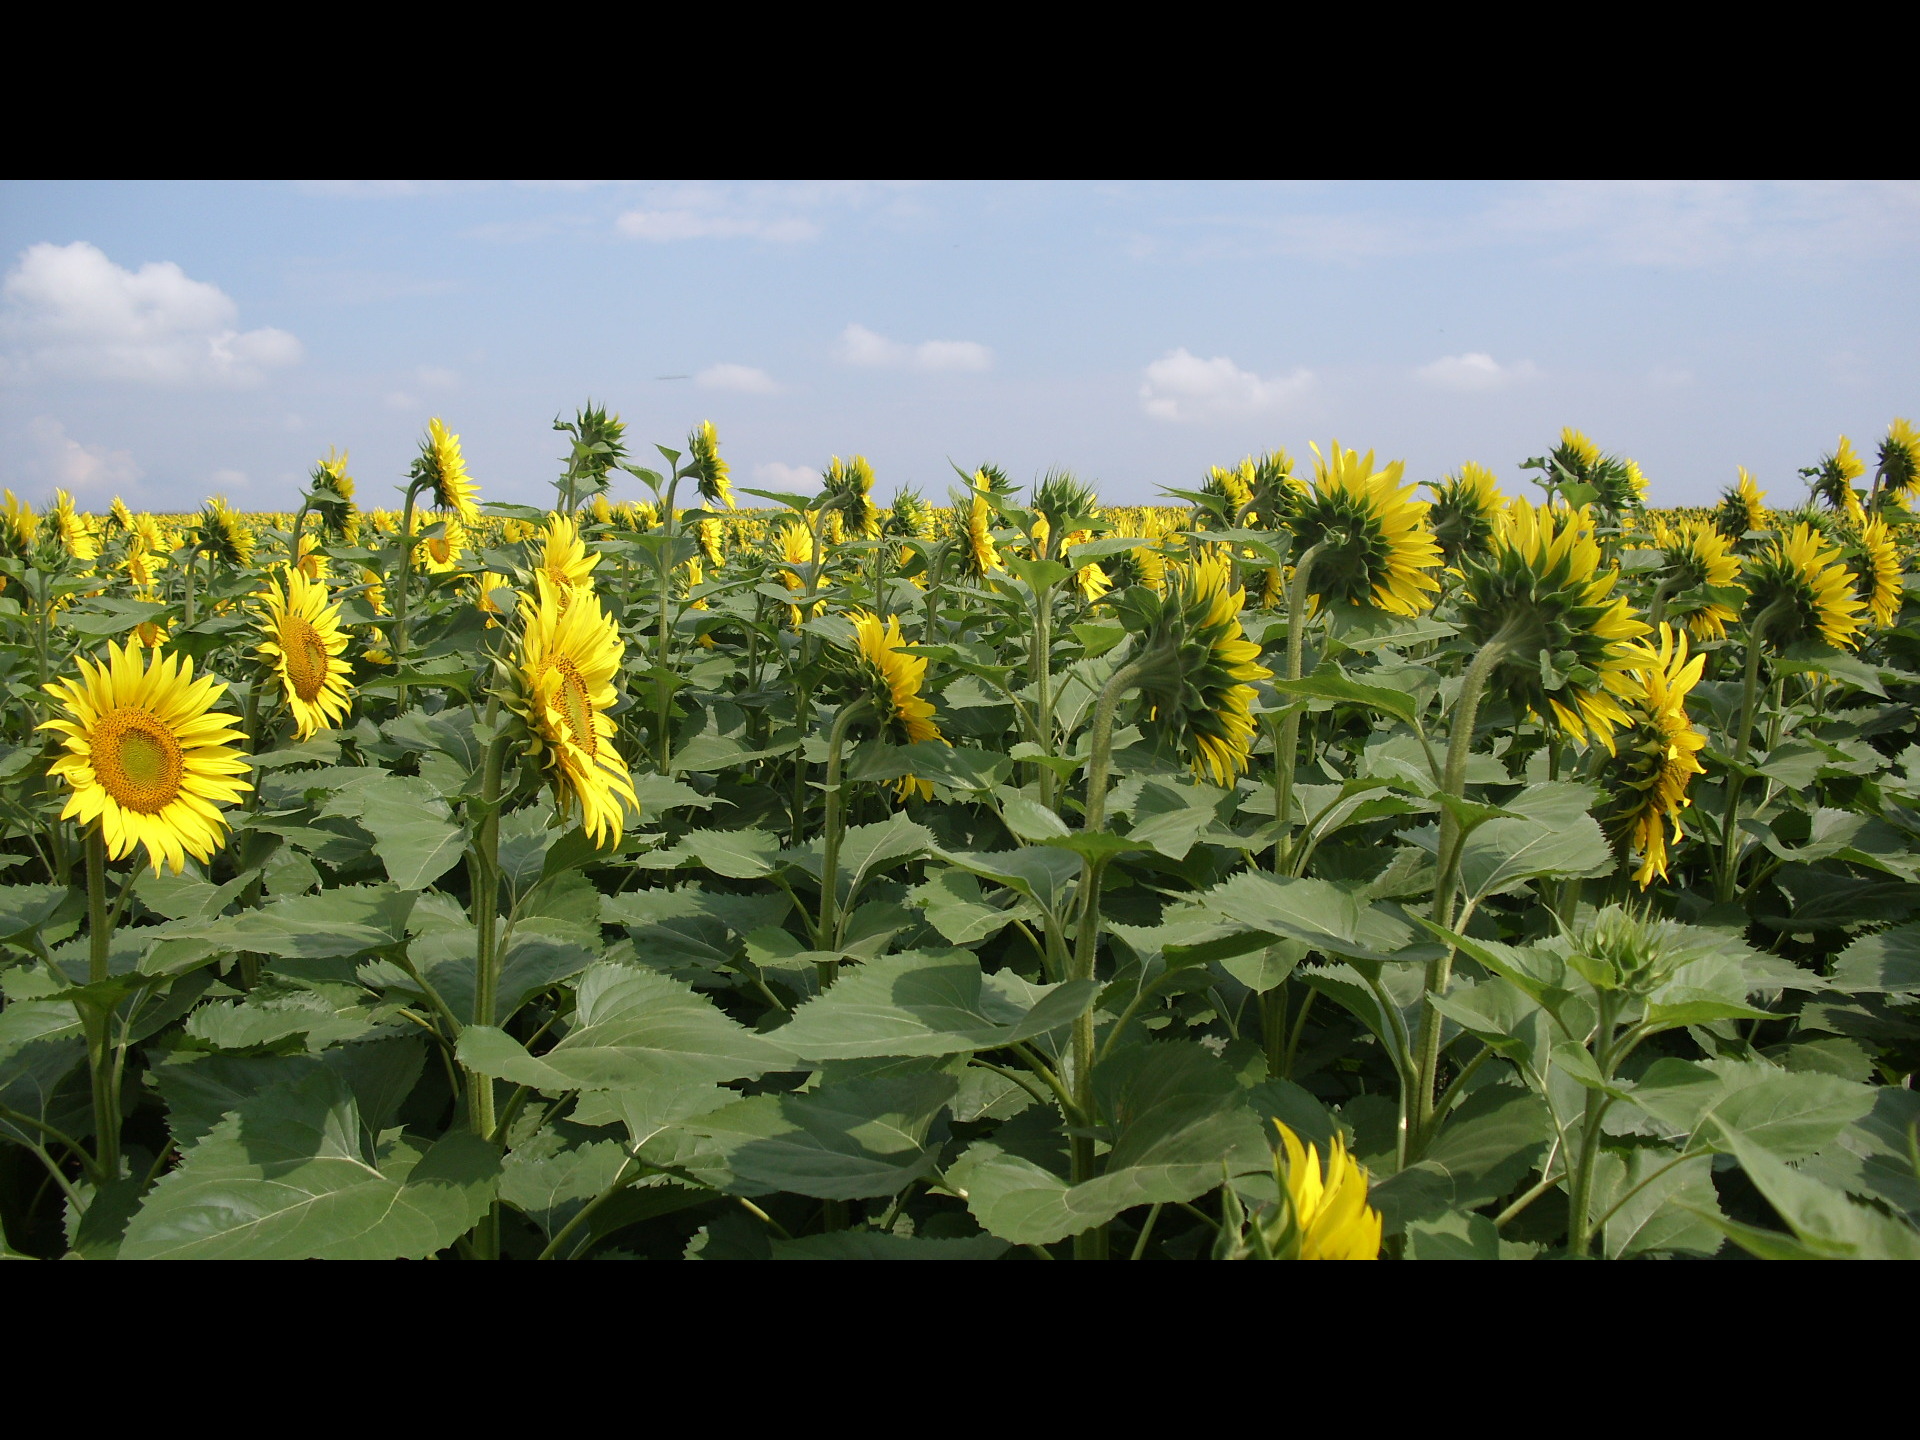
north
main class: Cropland
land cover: Sunflower
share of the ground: > 75 %
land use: Agriculture (excluding fallow land and kitchen gardens)
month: July
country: BG
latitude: 43.8124
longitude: 23.2082
